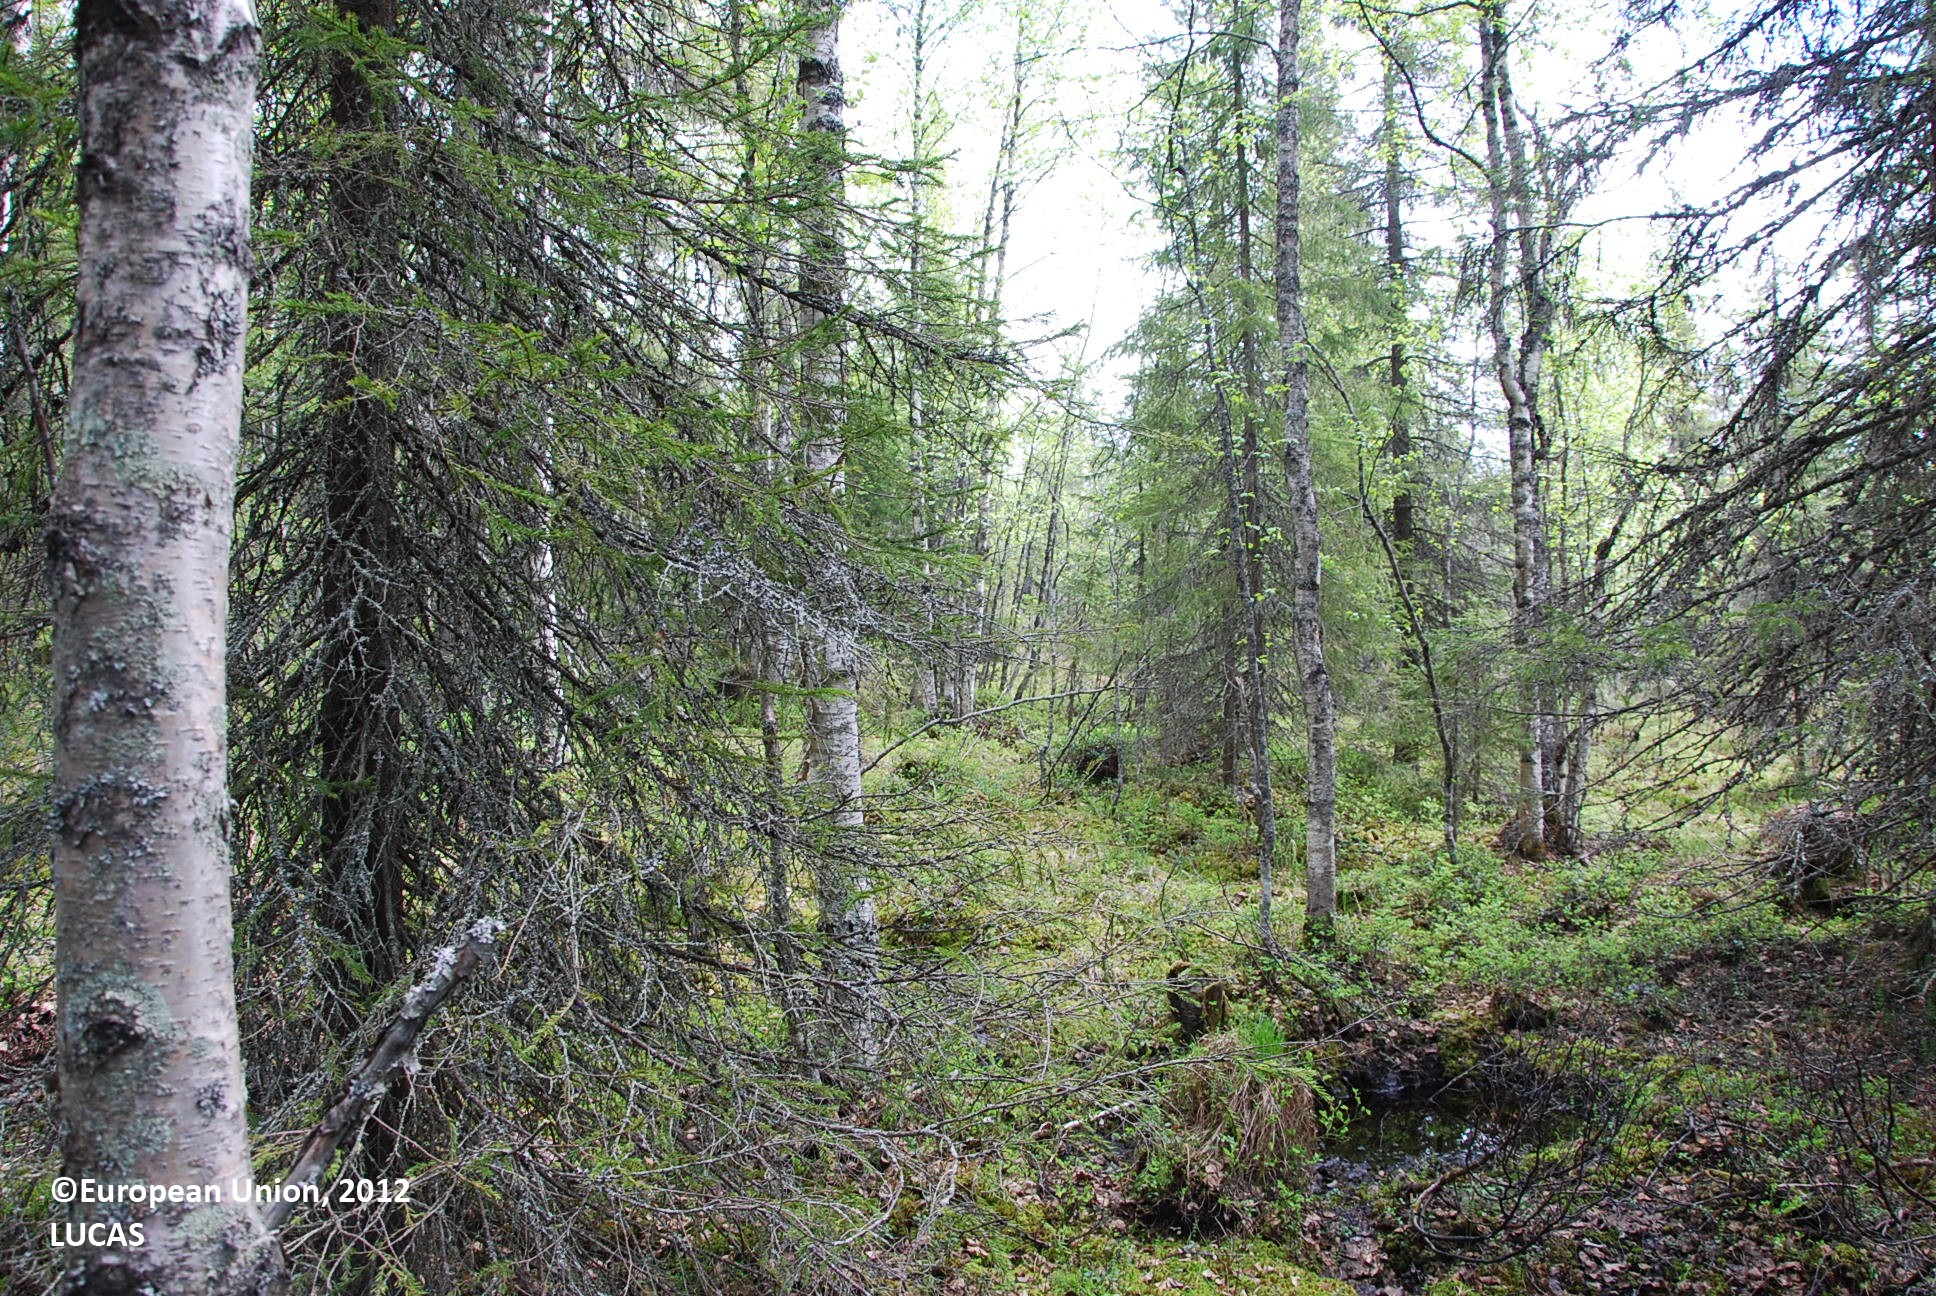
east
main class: Woodland
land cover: Spruce dominated mixed woodland
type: boreal forest
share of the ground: > 75 %
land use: Forestry
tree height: > 5 m
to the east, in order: Spruce dominated mixed woodland; Pine dominated mixed woodland; Other mixed woodland; Pine dominated coniferous woodland
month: June
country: FI
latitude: 66.2062
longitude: 27.6949
